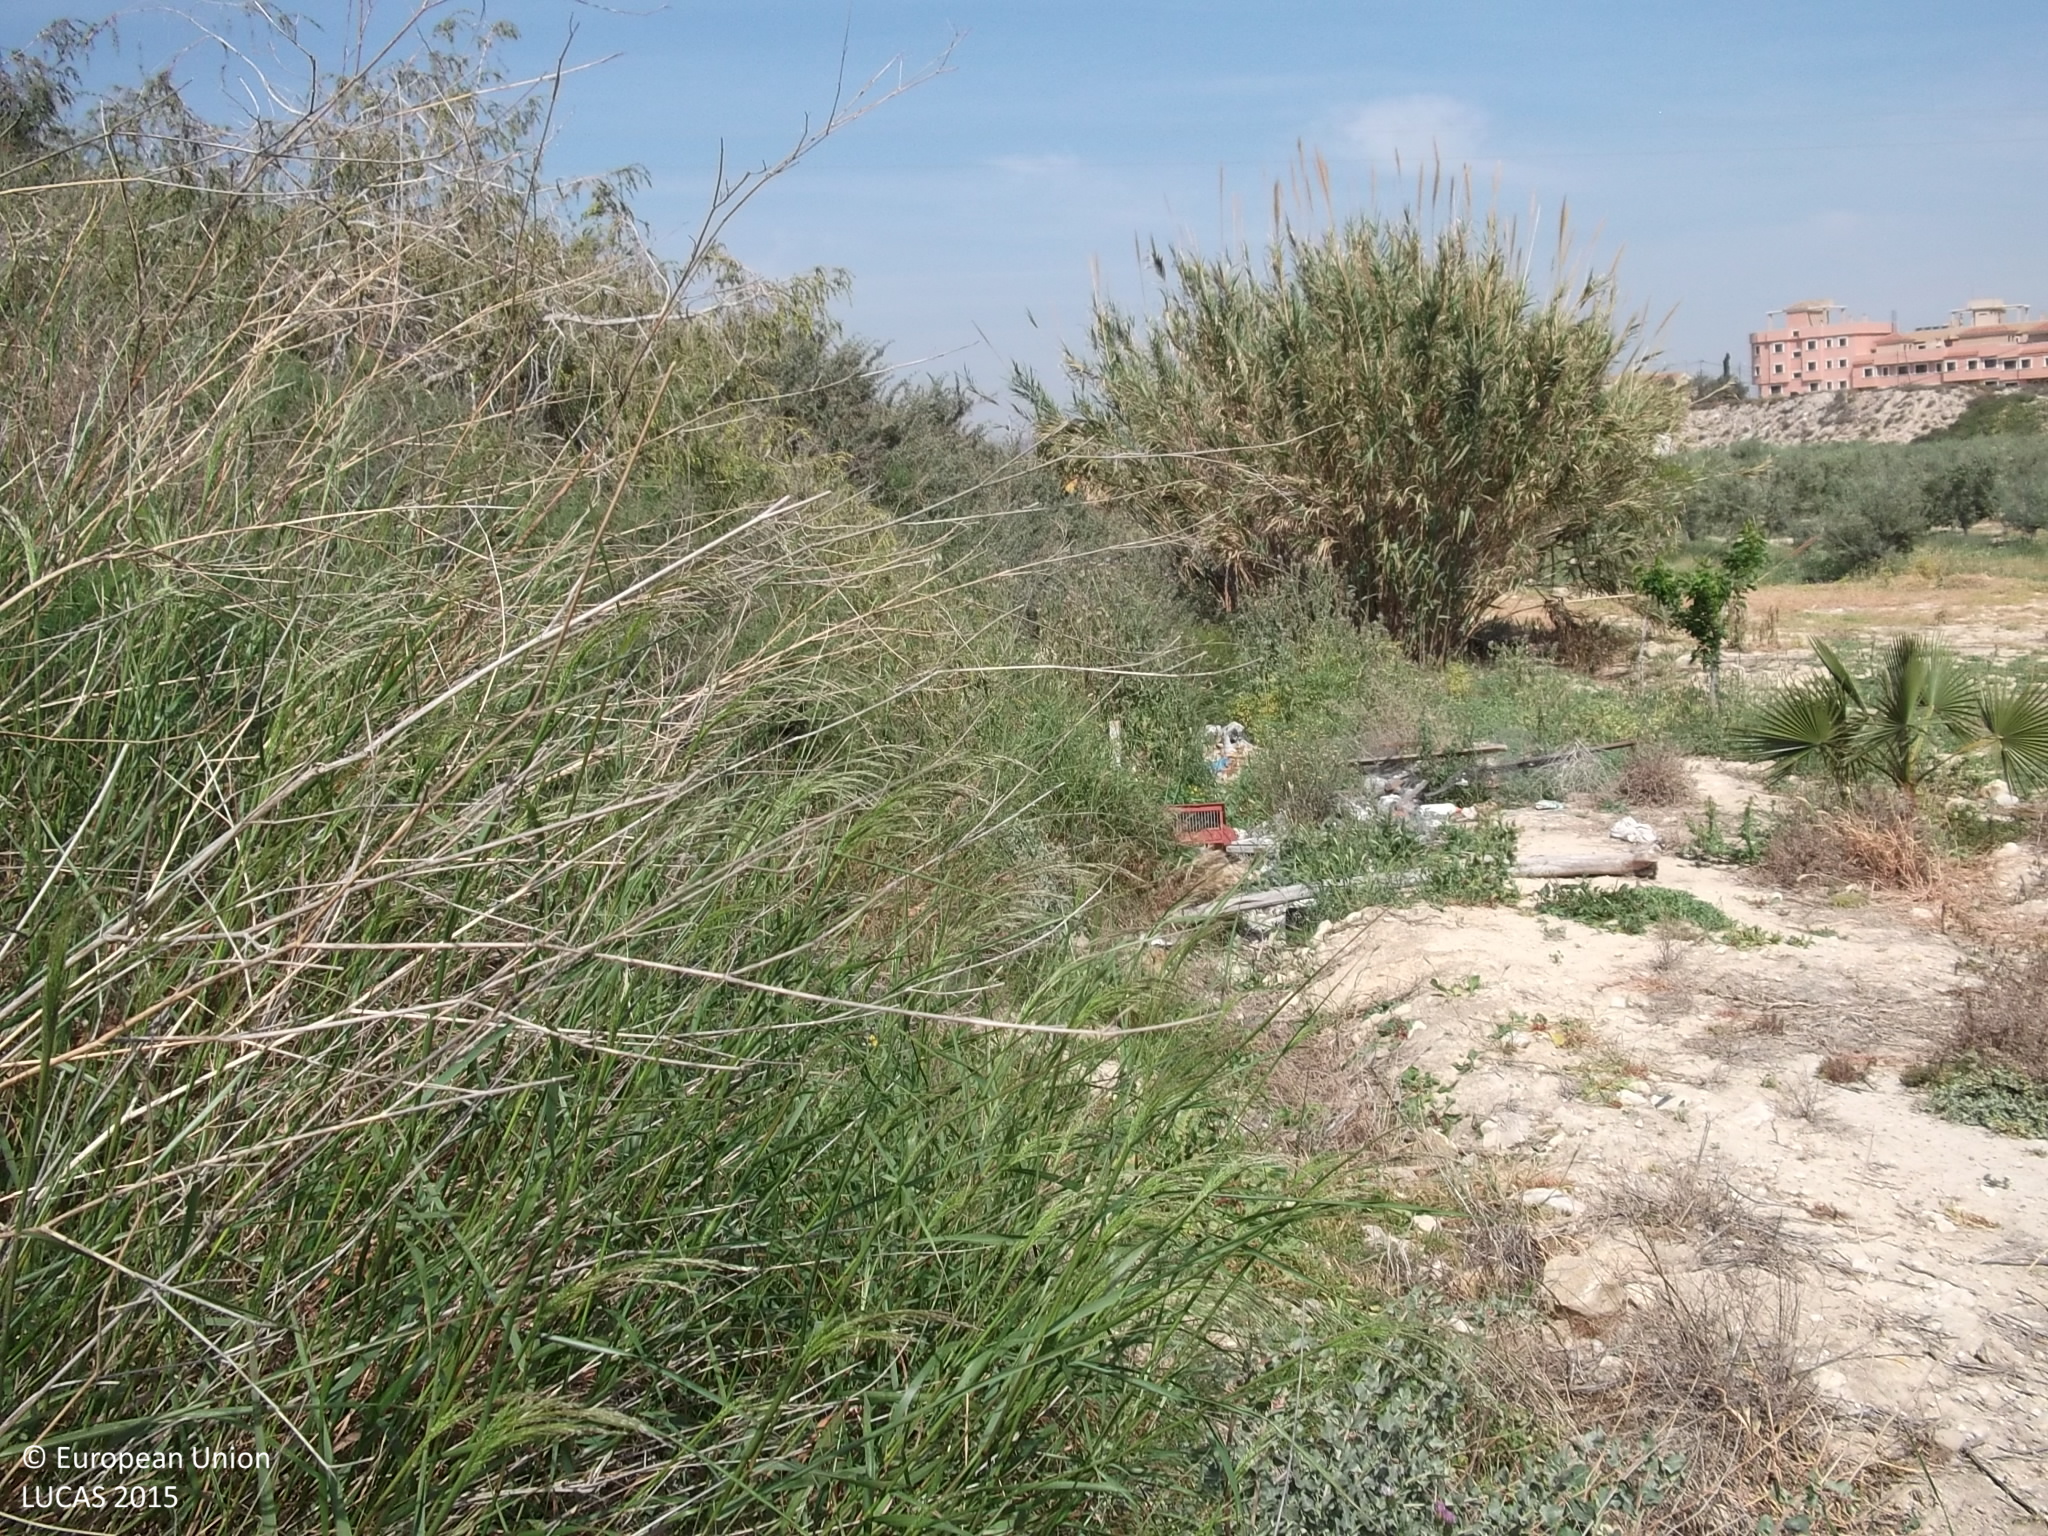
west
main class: Shrubland
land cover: Shrubland without tree cover
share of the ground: > 75 %
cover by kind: shrubs 85 %, herbaceous plants 15 %
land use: Abandoned areas
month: April
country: ES
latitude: 38.0243
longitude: -0.9766
